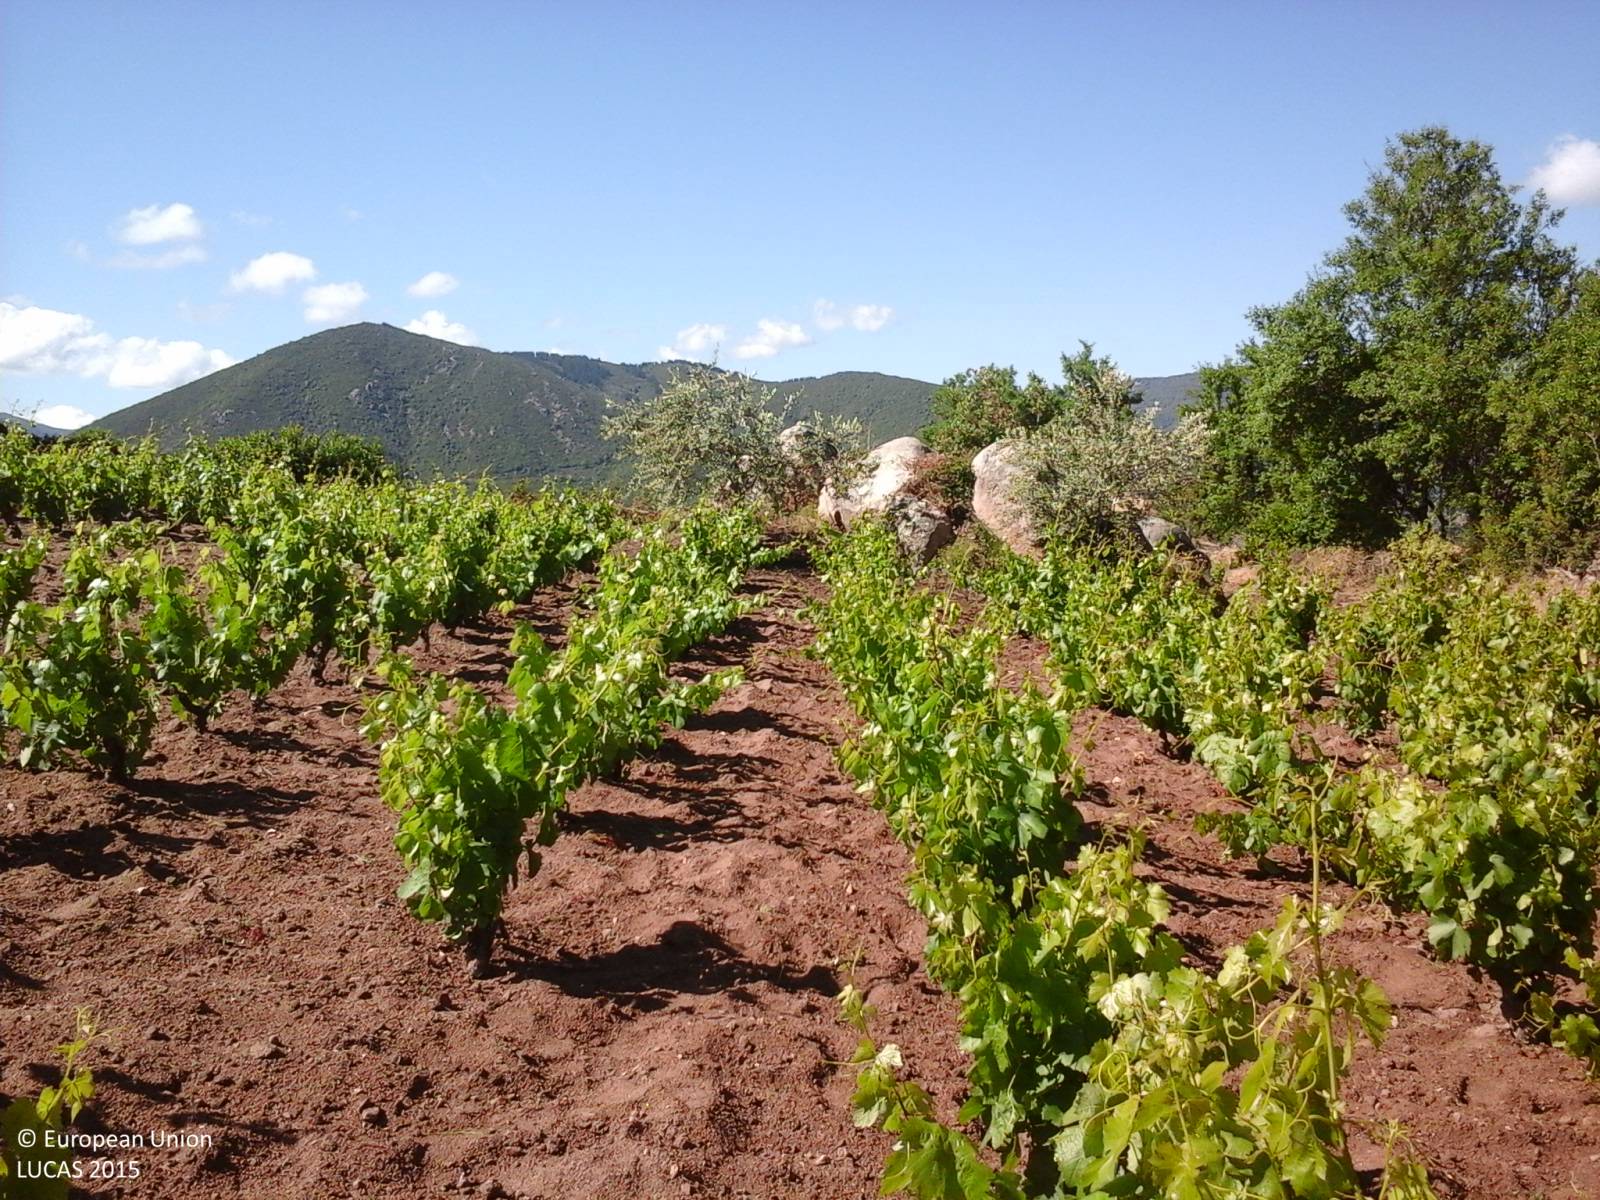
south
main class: Cropland
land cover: Vineyards
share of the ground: 50 - 75 %
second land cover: Other bare soil
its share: > 75 %
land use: Agriculture (excluding fallow land and kitchen gardens)
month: May
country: IT
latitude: 40.2293
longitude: 9.4038
